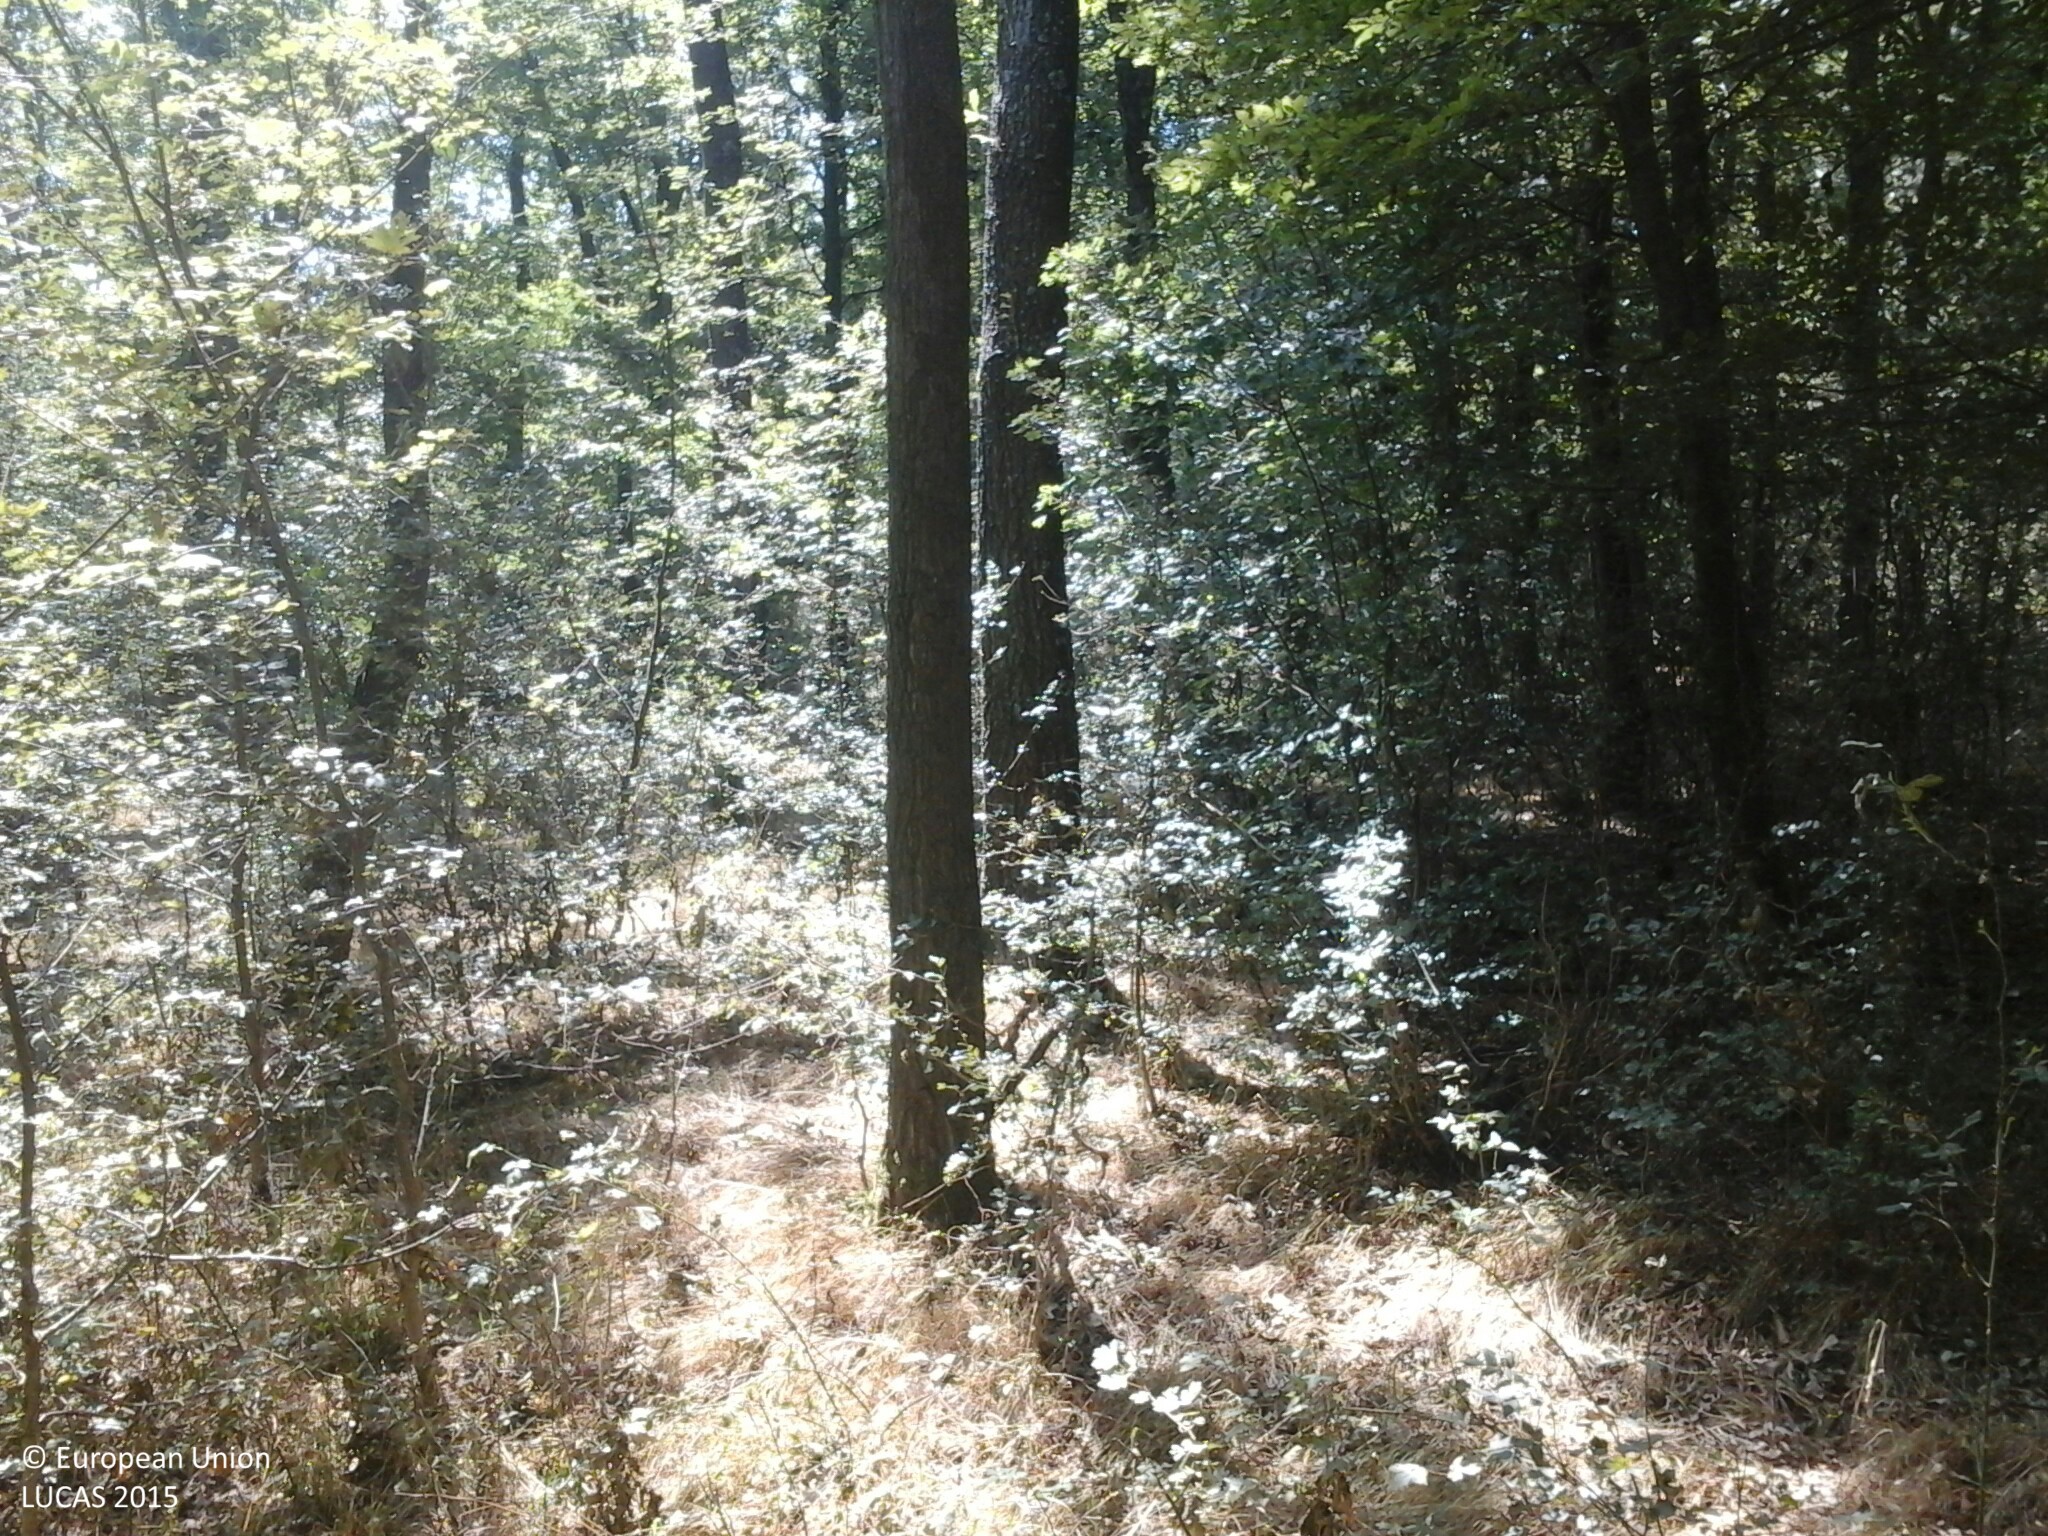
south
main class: Woodland
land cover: Broadleaved woodland
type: acidophilous oak and oak-birch forest
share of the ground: > 75 %
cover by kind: broadleaved forest trees 75 %, shrubs 15 %, herbaceous plants 10 %
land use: Forestry
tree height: < 5 m
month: July
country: HU
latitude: 47.1972
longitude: 17.9159
